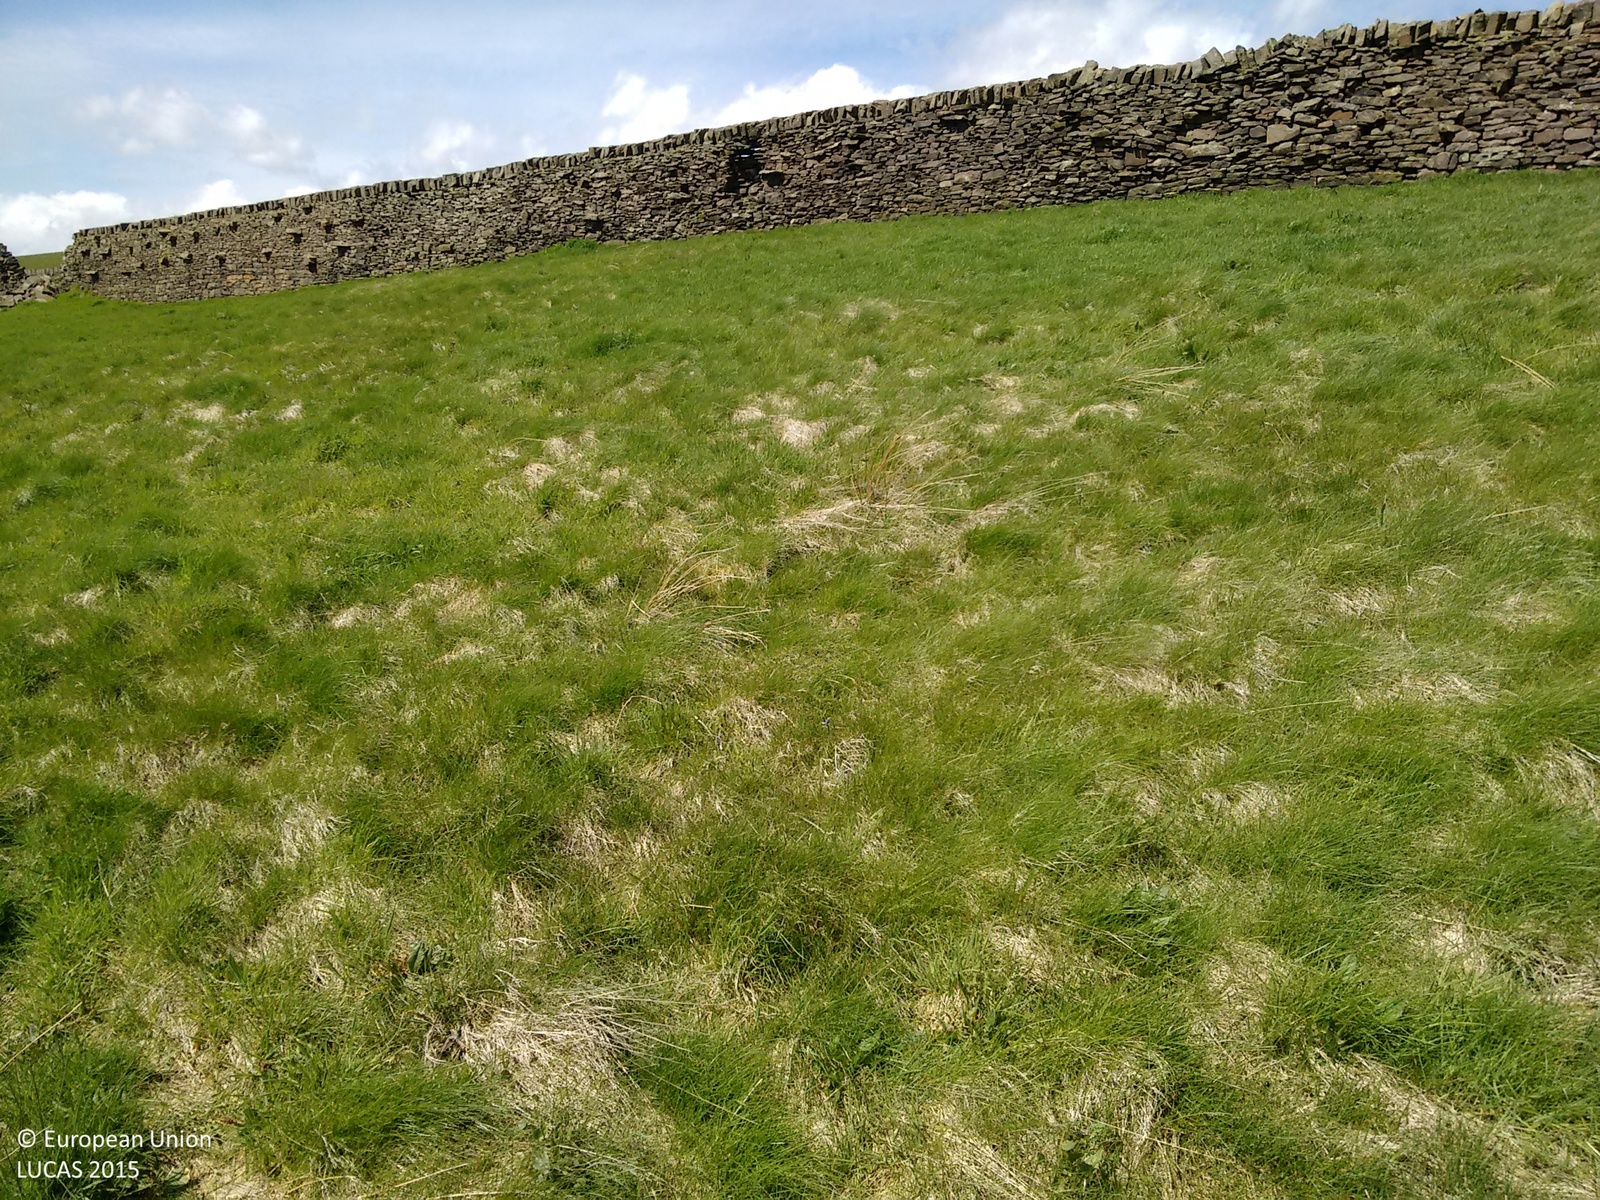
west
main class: Grassland
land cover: Grassland without tree/shrub cover
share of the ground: > 75 %
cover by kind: herbaceous plants 100 %
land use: Agriculture (excluding fallow land and kitchen gardens)
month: May
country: GB
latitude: 53.5634
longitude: -1.8466
